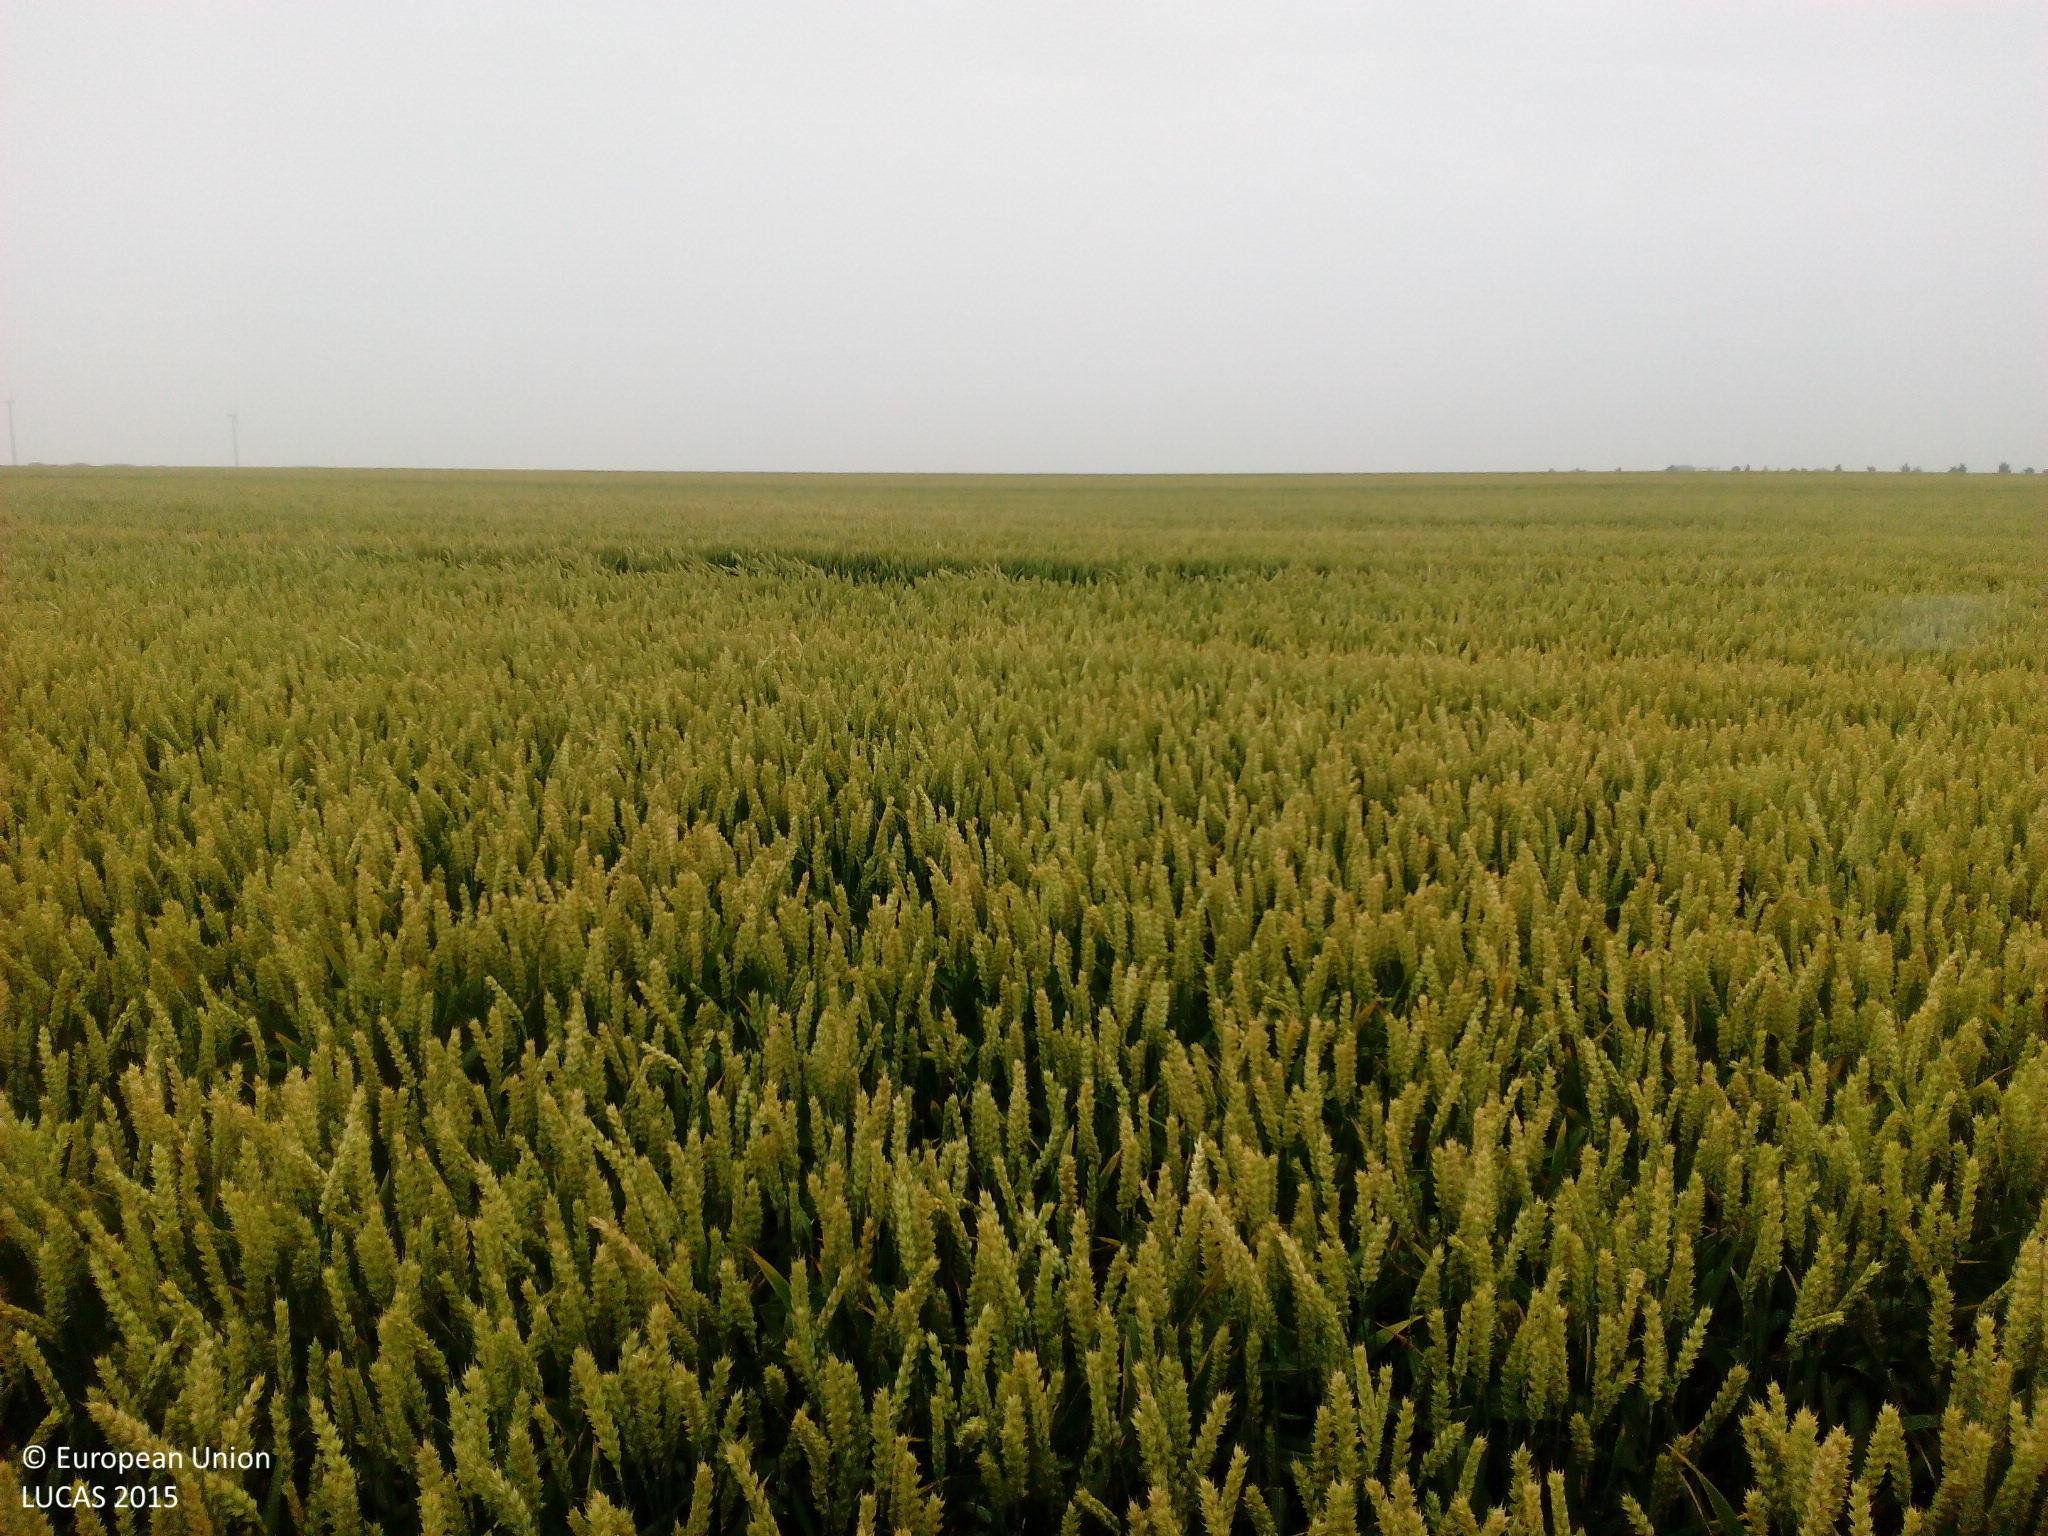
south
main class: Cropland
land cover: Common wheat
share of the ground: > 75 %
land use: Agriculture (excluding fallow land and kitchen gardens)
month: July
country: DE
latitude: 51.8111
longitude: 11.4646
